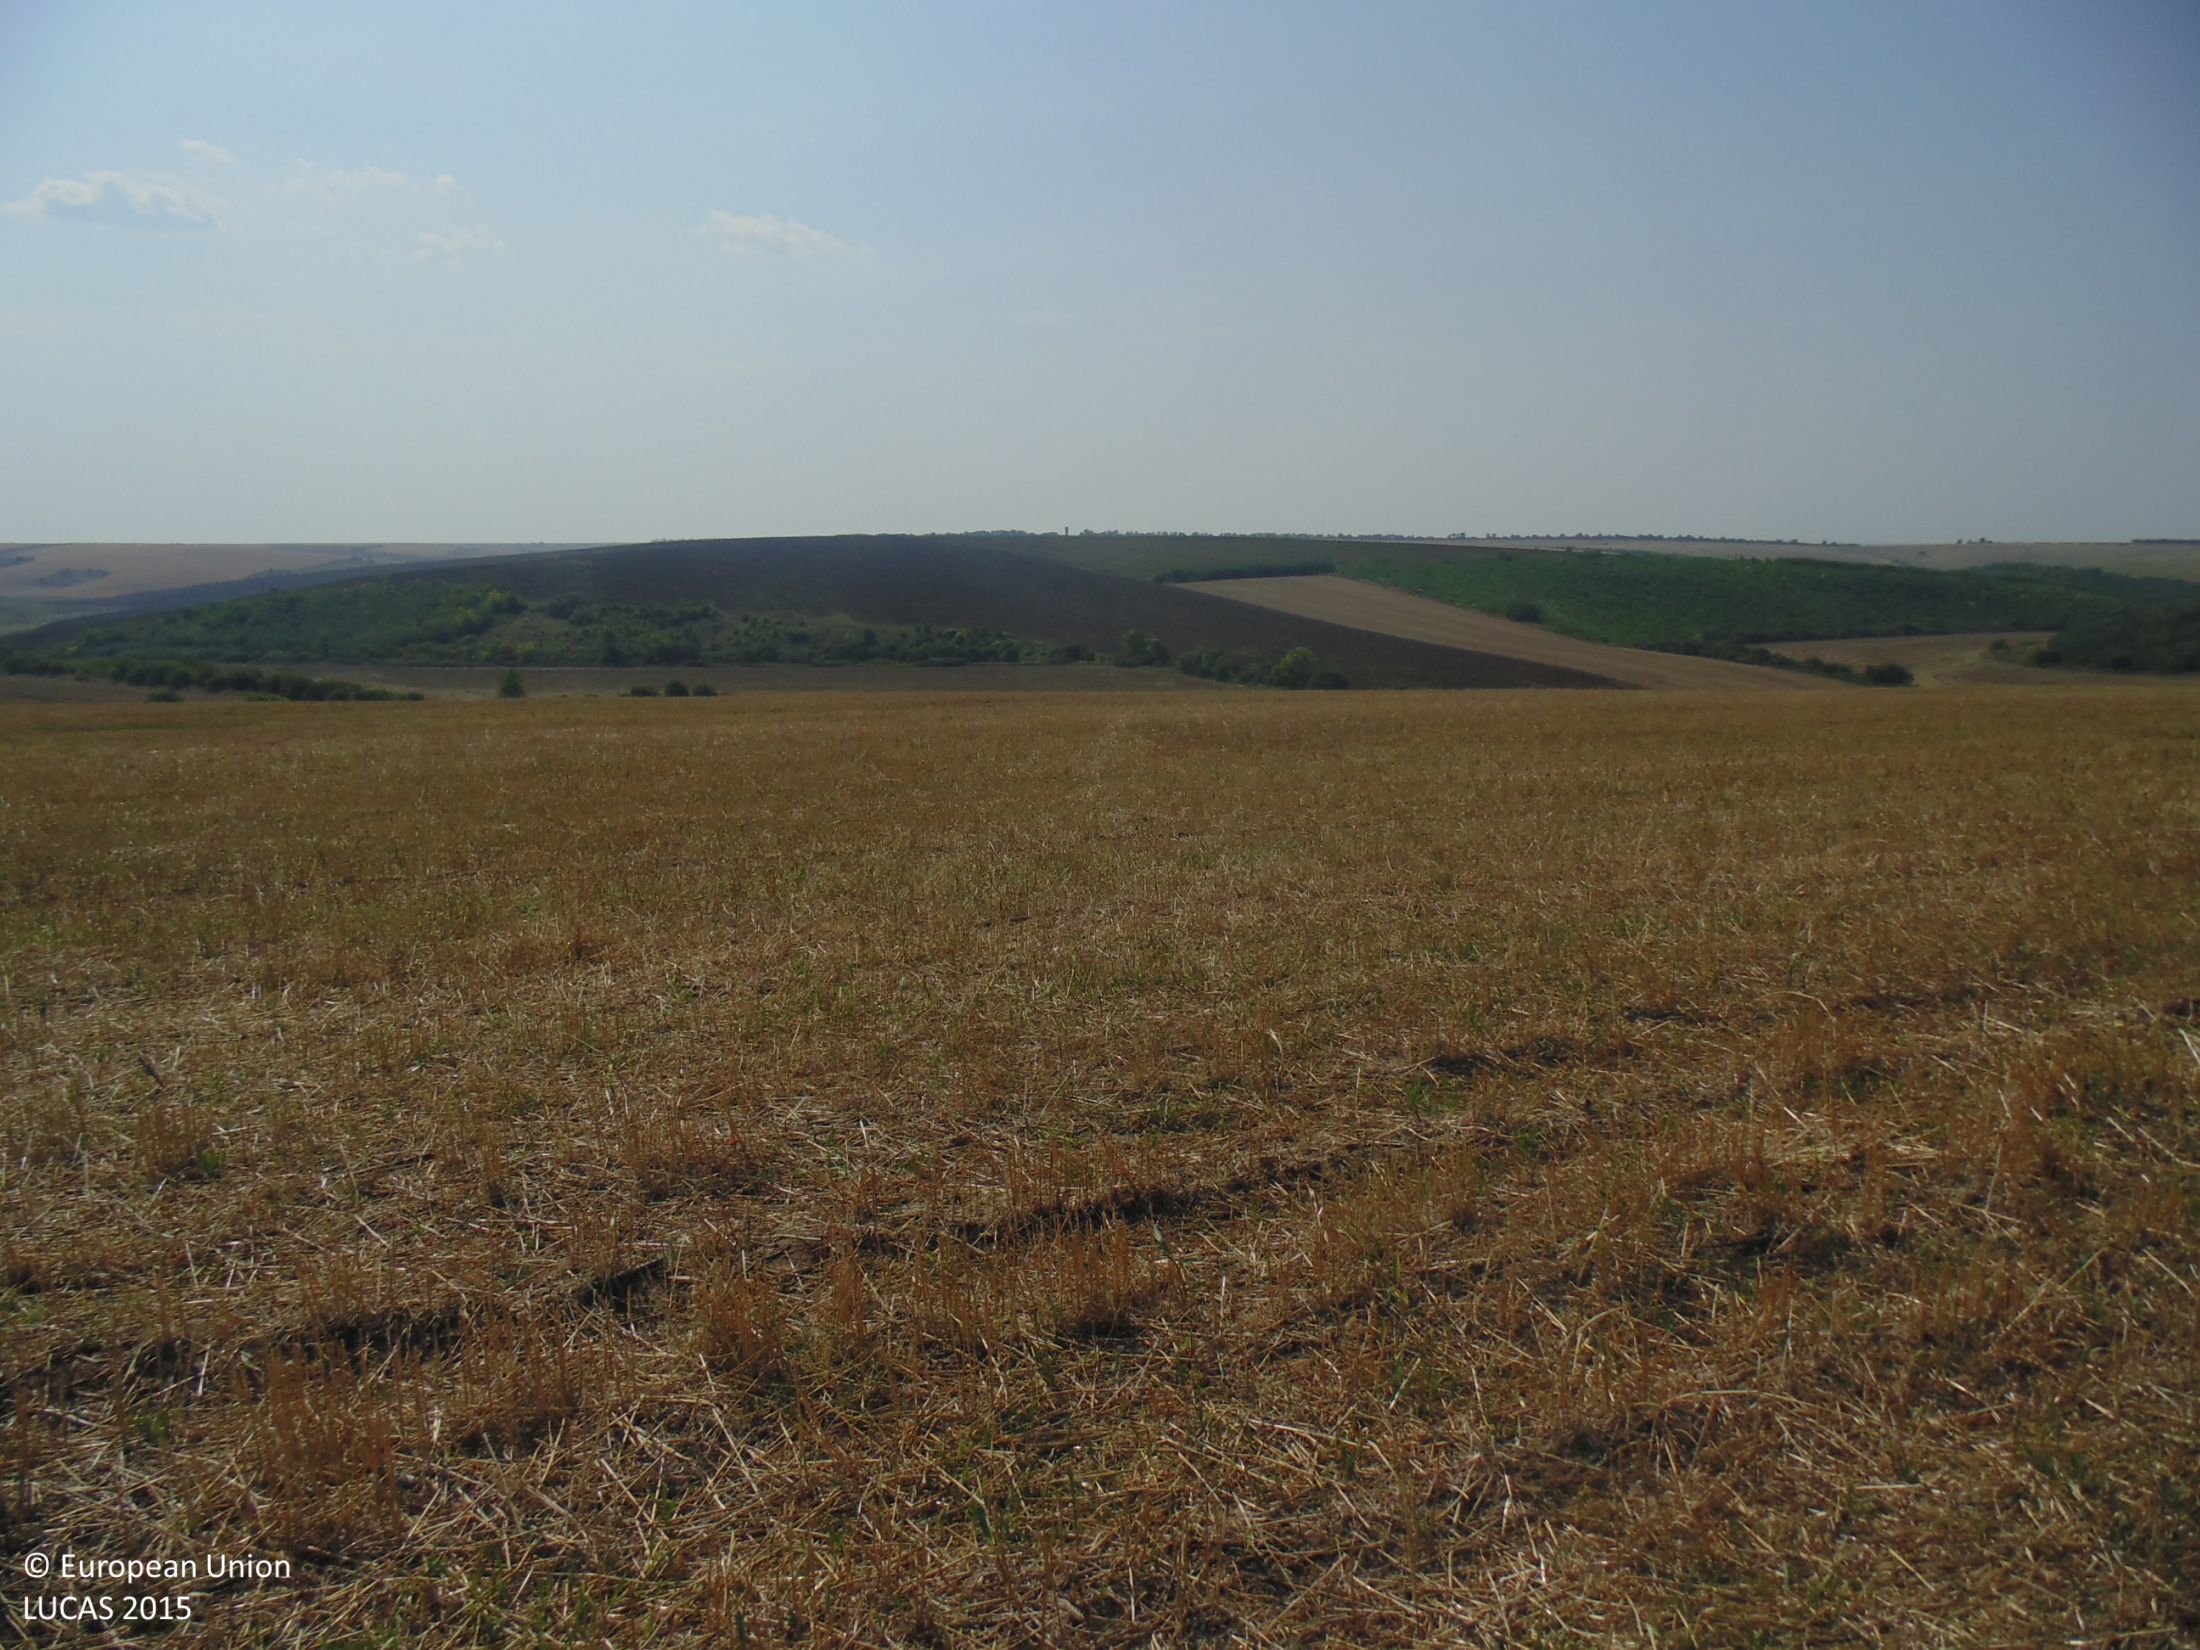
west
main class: Cropland
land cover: Barley
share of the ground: 25 - 50 %
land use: Agriculture (excluding fallow land and kitchen gardens)
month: August
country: BG
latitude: 43.9887
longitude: 27.3005
